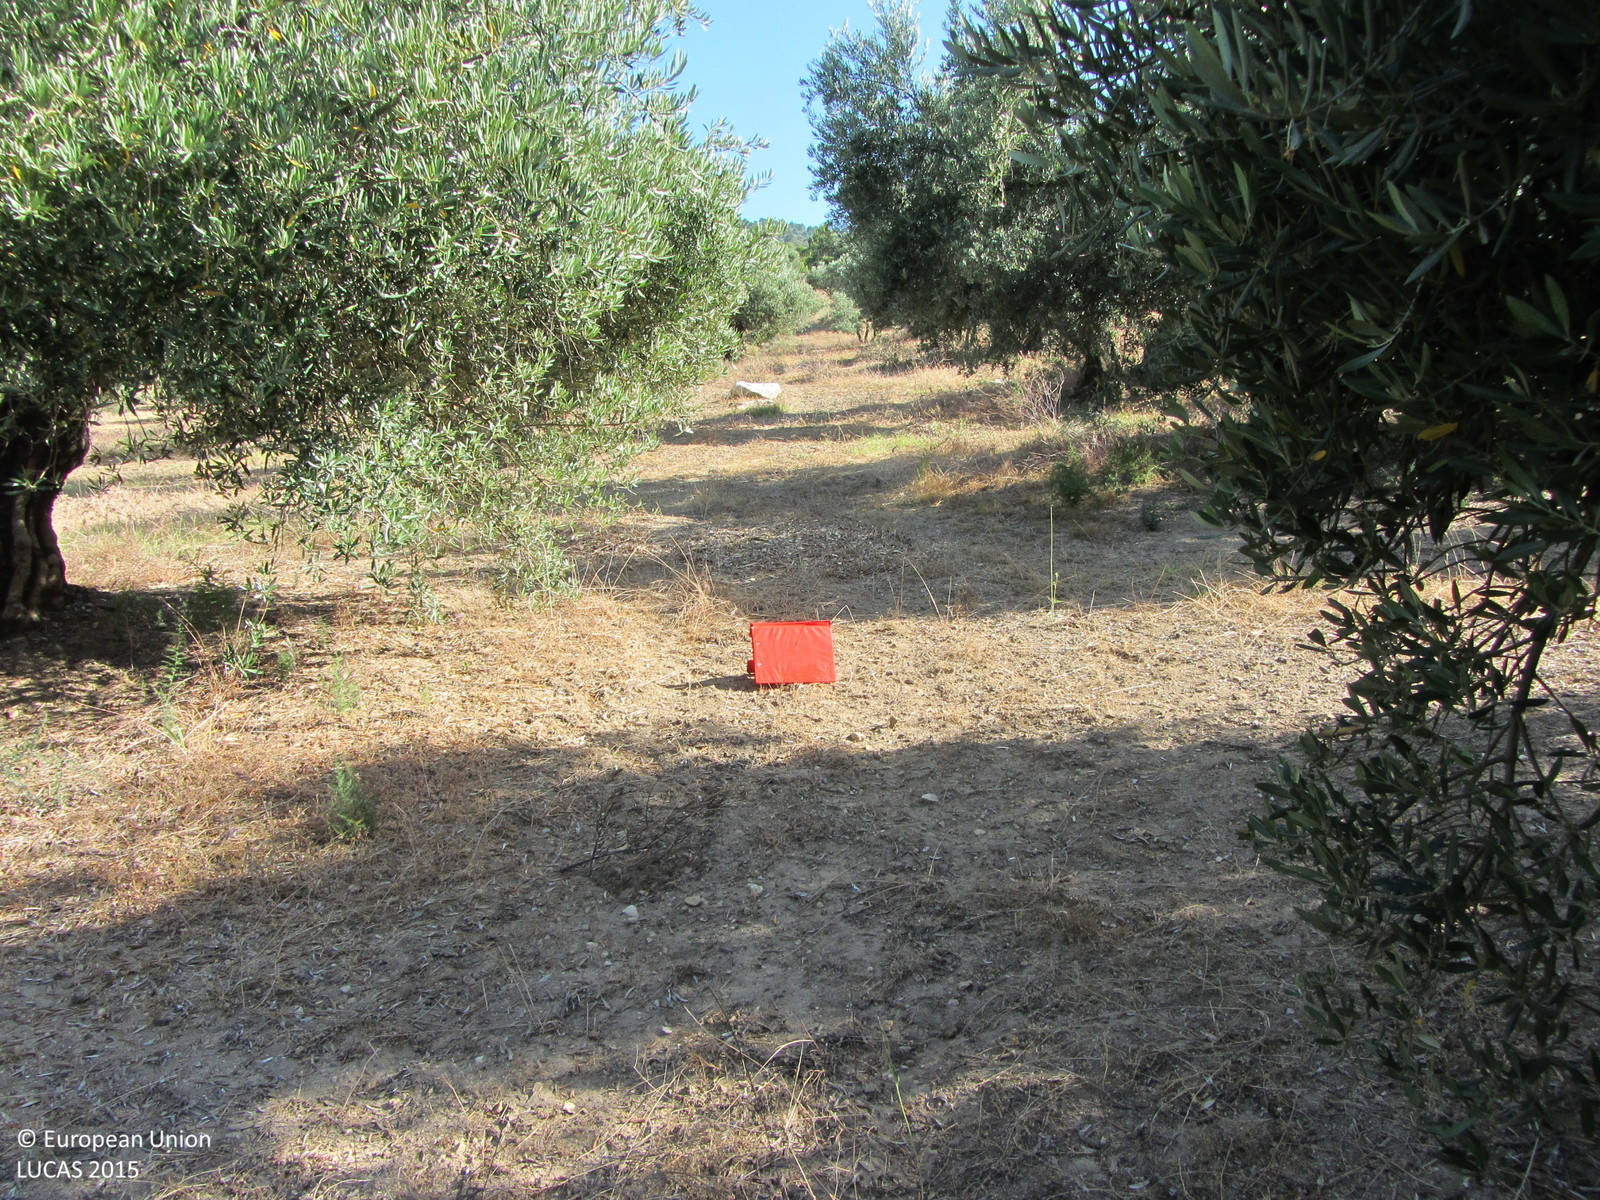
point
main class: Cropland
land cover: Olive groves
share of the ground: 50 - 75 %
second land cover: Other bare soil
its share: > 75 %
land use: Agriculture (excluding fallow land and kitchen gardens)
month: June
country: ES
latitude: 38.1927
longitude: -2.8429
